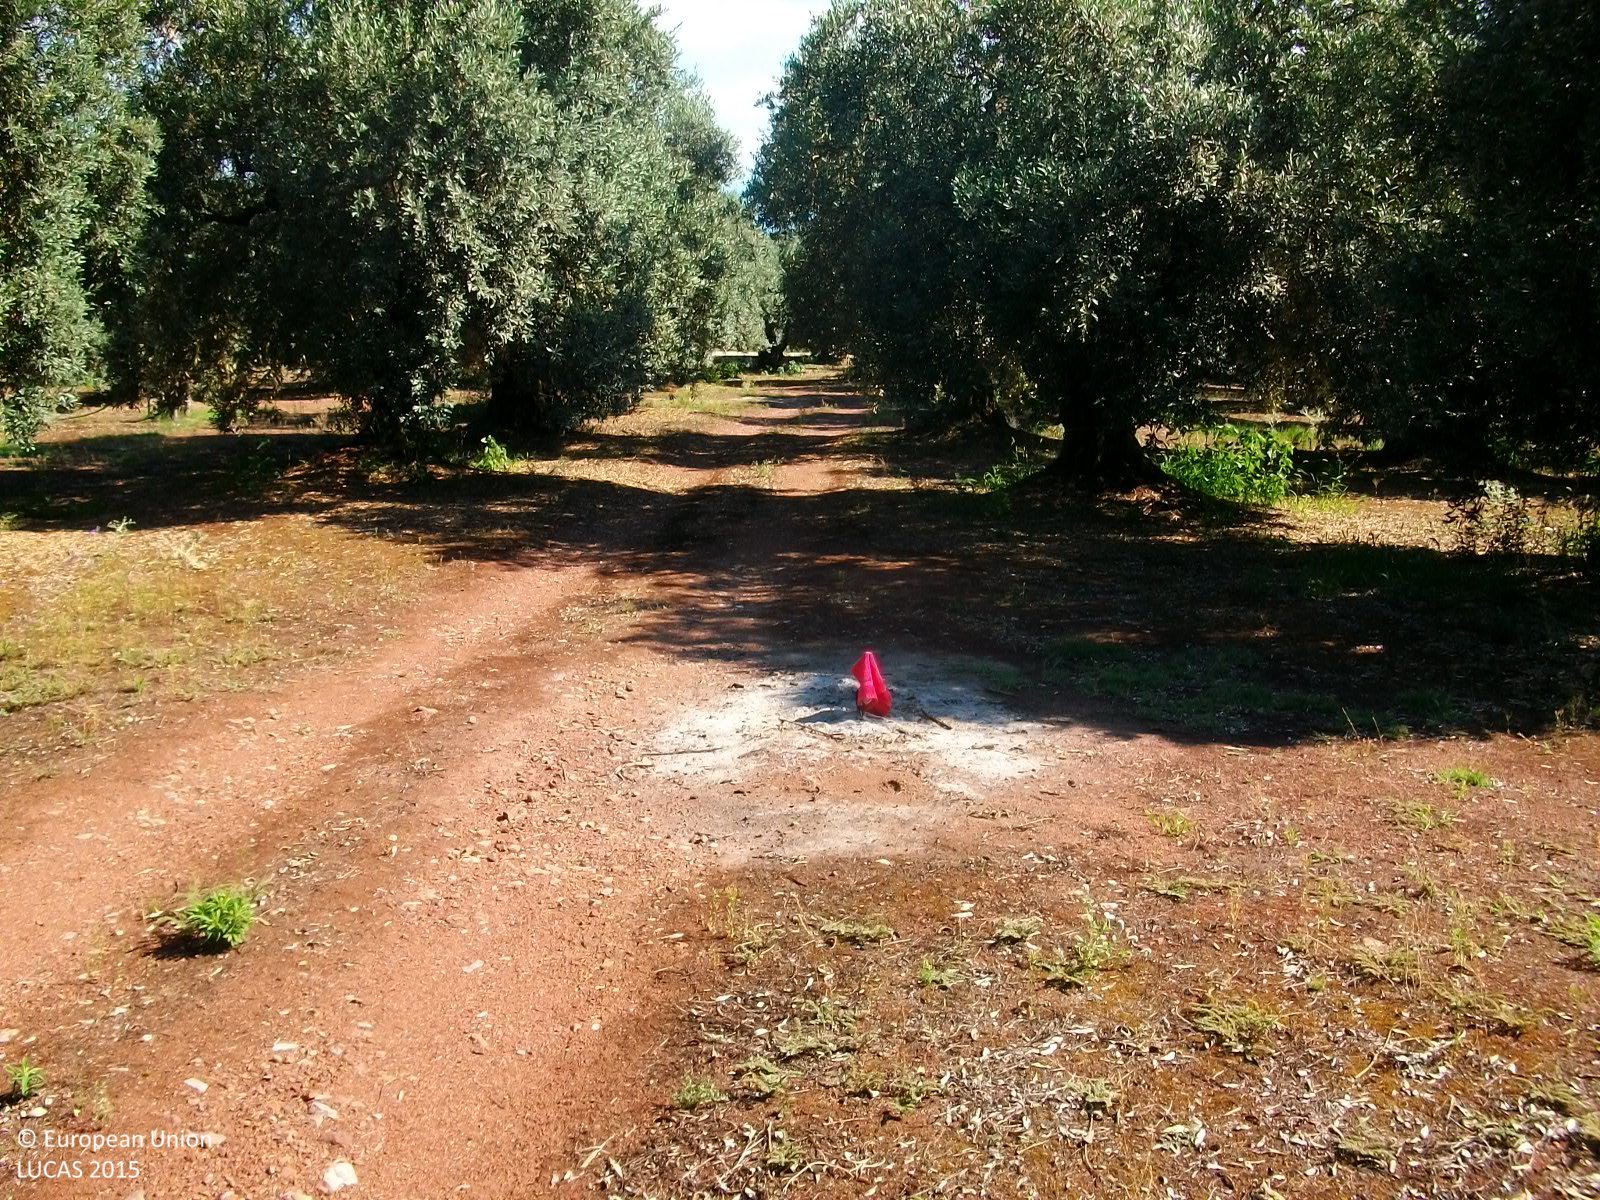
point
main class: Cropland
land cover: Olive groves
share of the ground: > 75 %
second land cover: Spontaneously vegetated surfaces
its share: 25 - 50 %
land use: Agriculture (excluding fallow land and kitchen gardens)
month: June
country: GR
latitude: 38.9163
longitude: 22.6345
